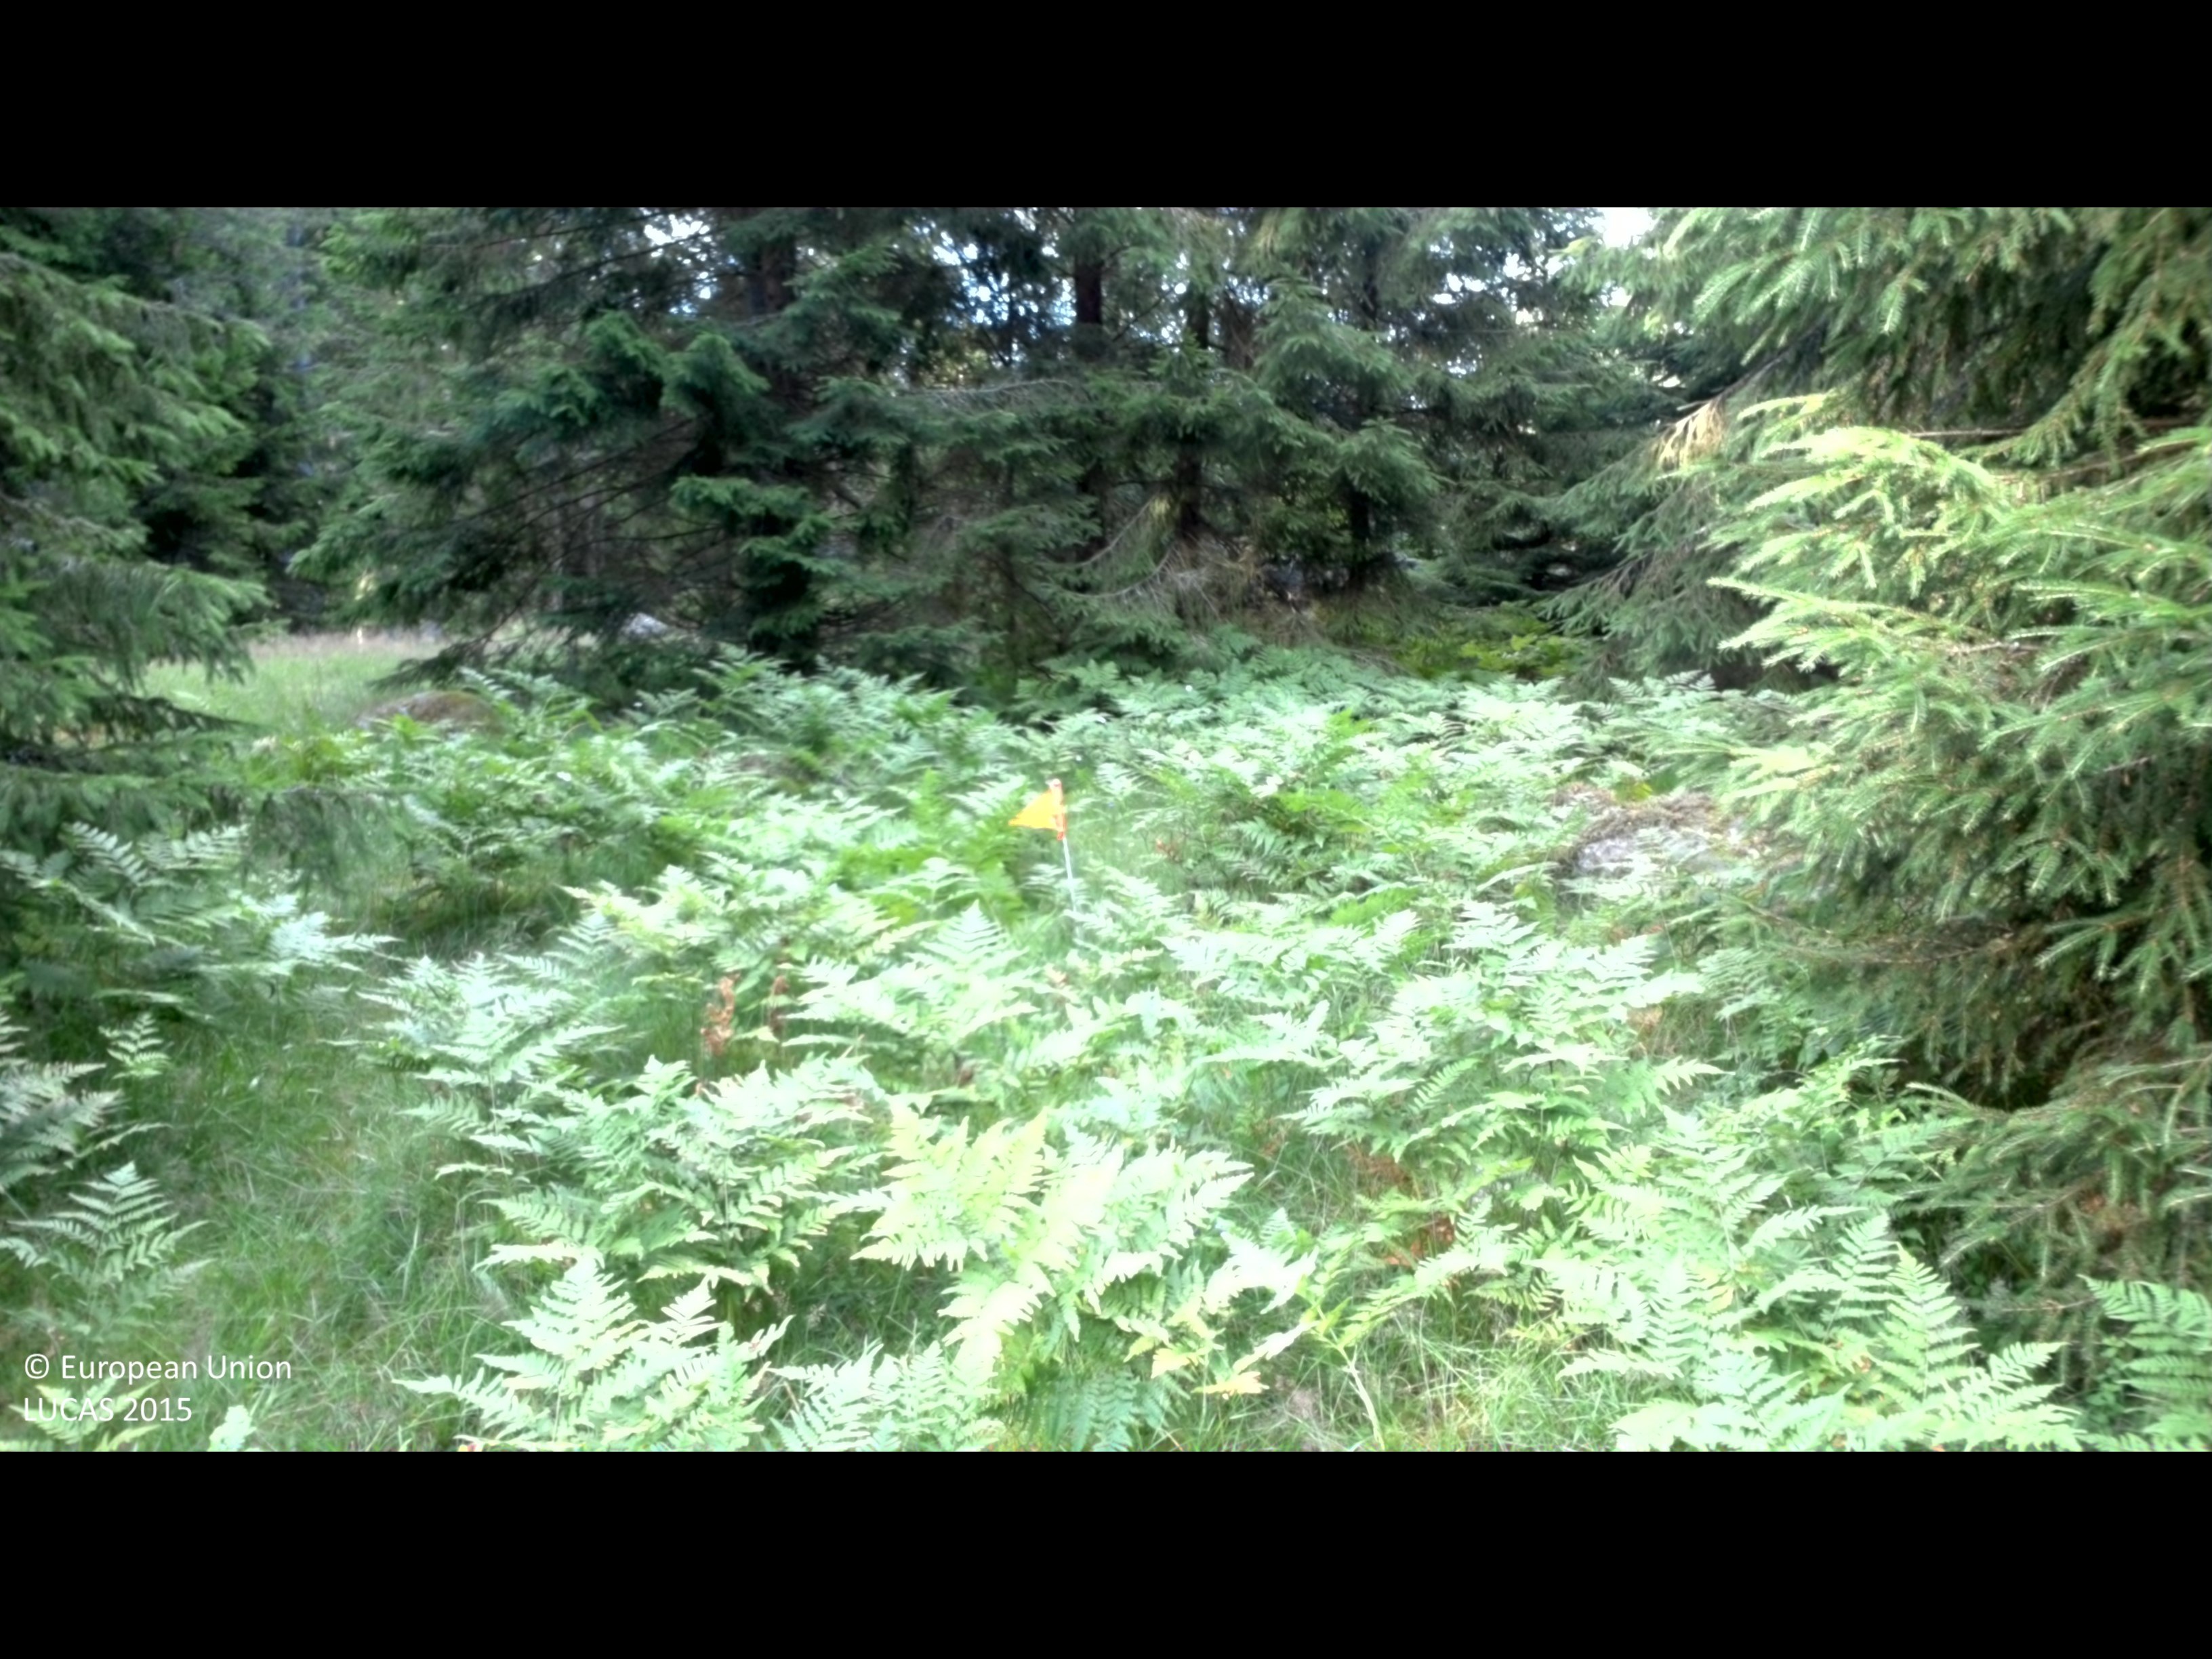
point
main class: Grassland
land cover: Grassland with sparse tree/shrub cover
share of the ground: > 75 %
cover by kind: herbaceous plants 95 %, coniferous forest trees 5 %
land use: Forestry
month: July
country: SE
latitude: 56.4254
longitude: 14.7160
